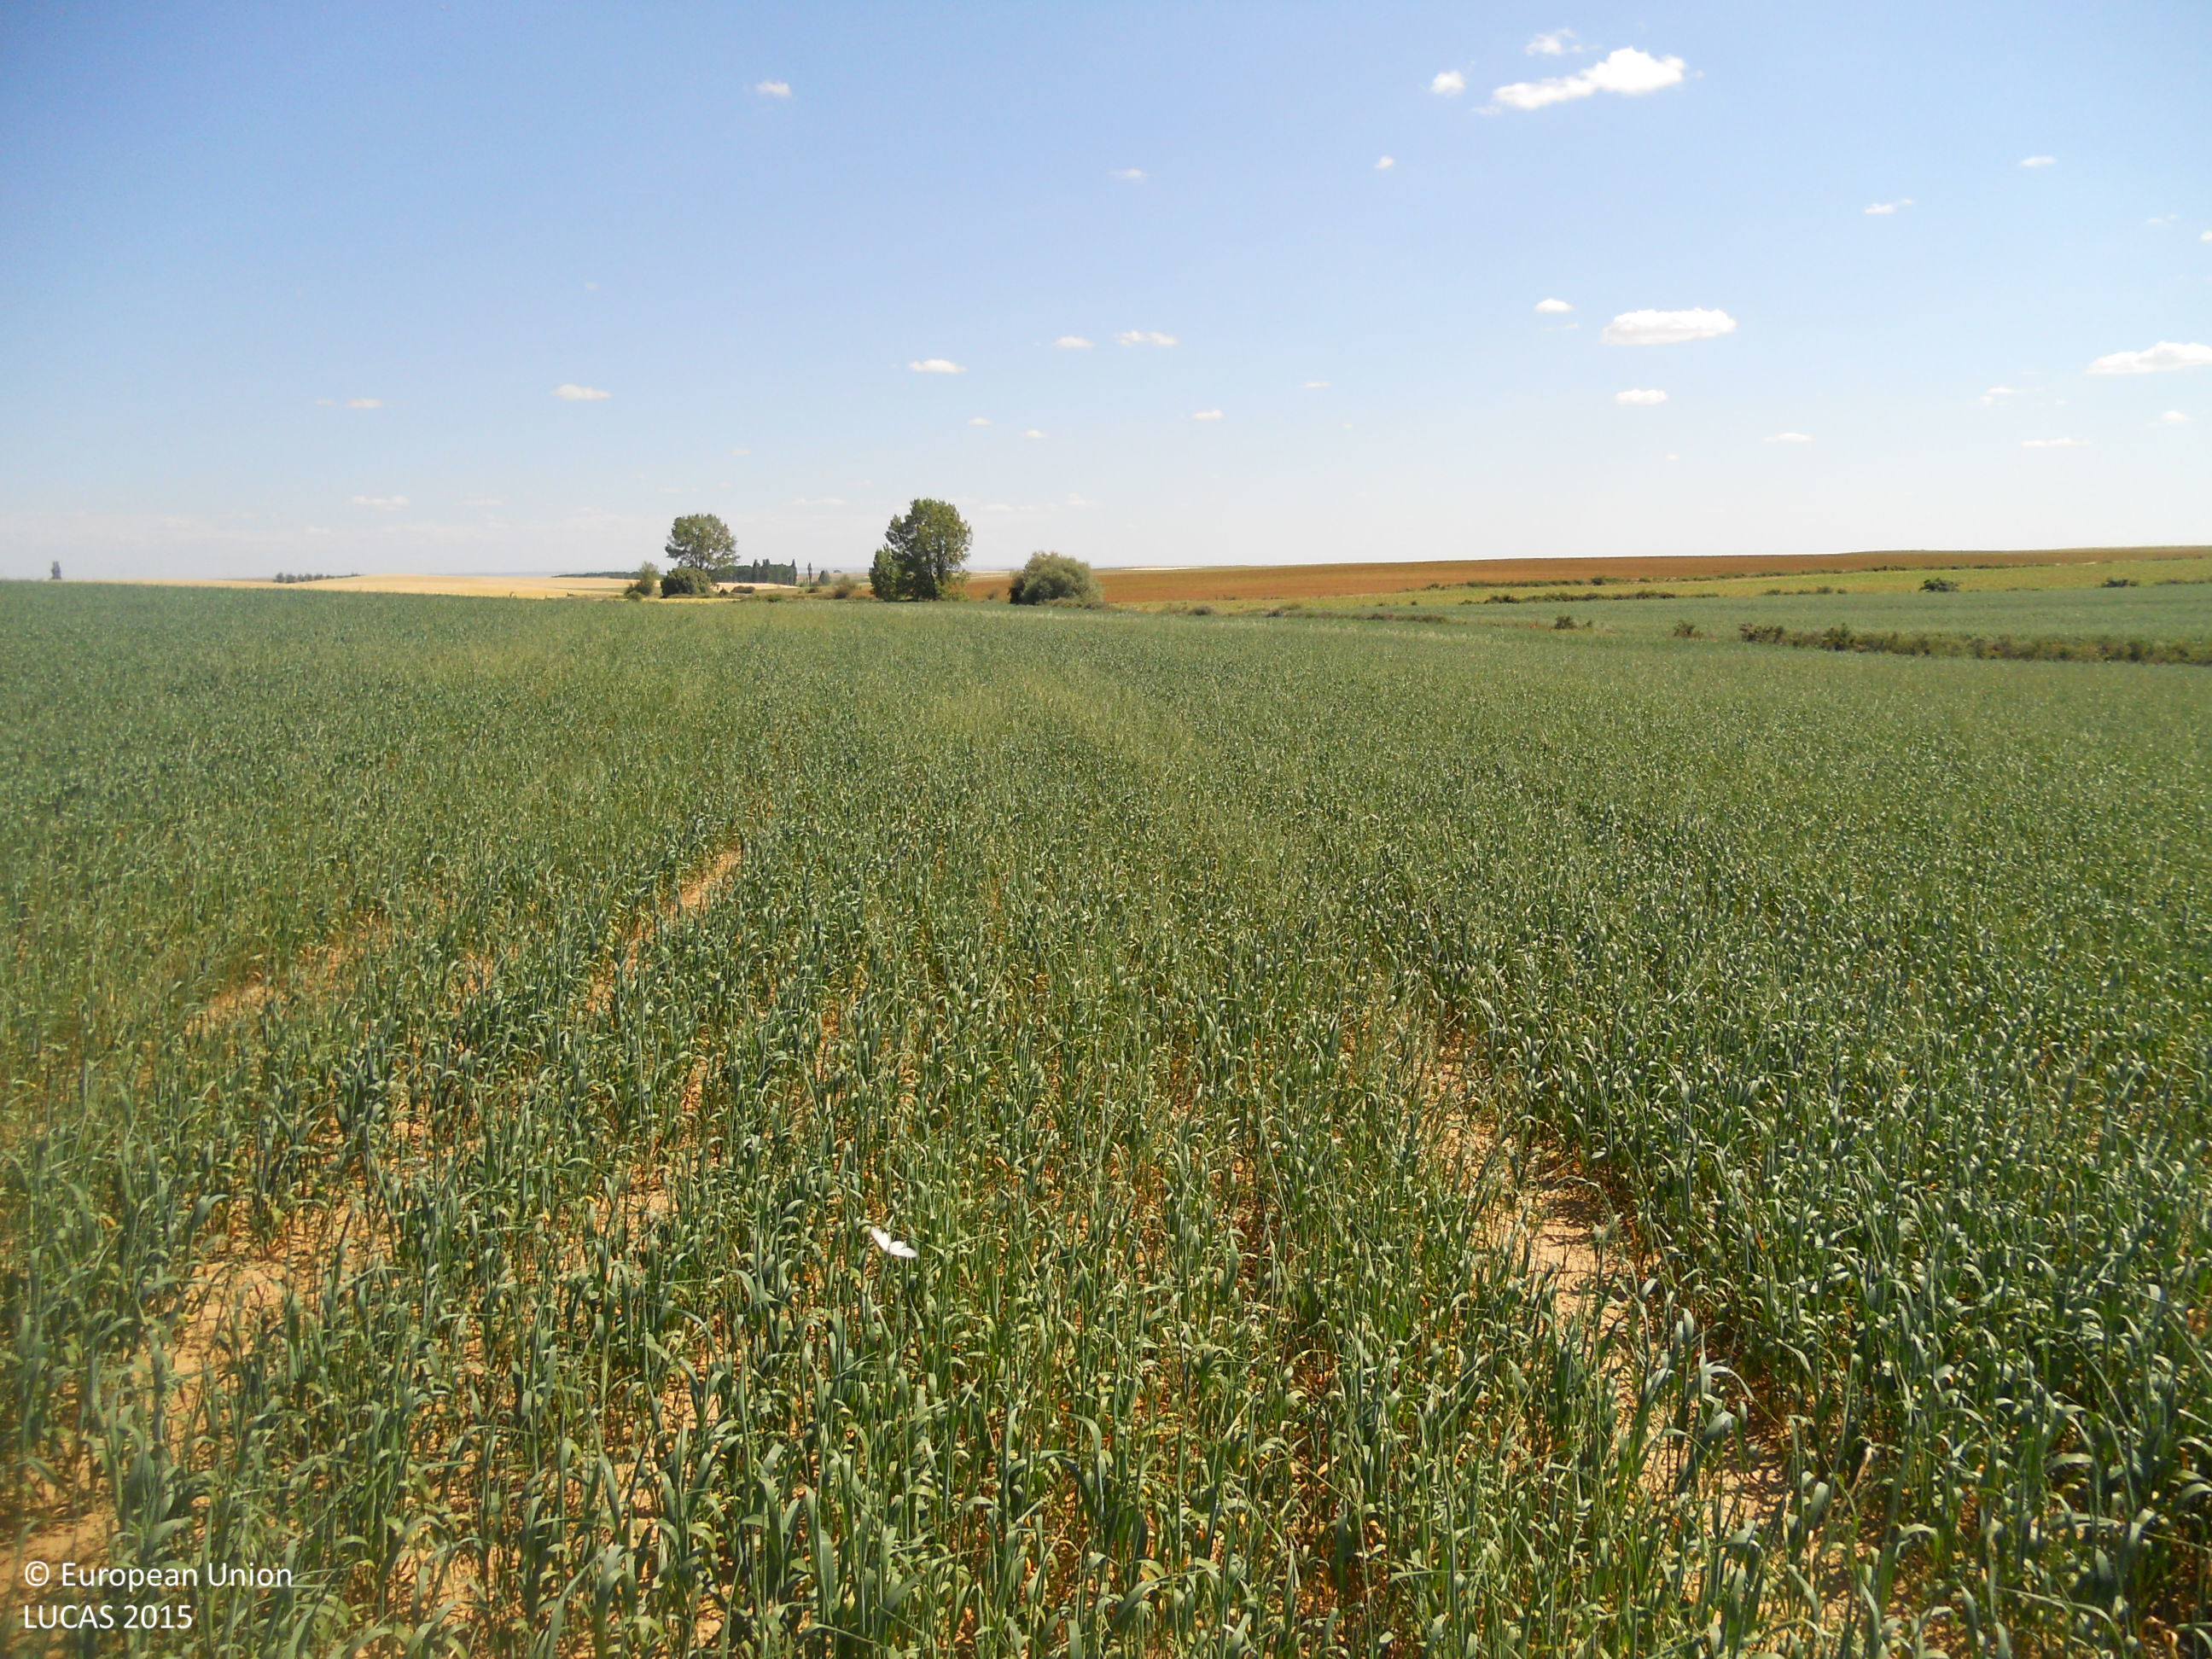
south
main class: Cropland
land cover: Oats
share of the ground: > 75 %
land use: Agriculture (excluding fallow land and kitchen gardens)
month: May
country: ES
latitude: 42.2732
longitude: -4.8099
